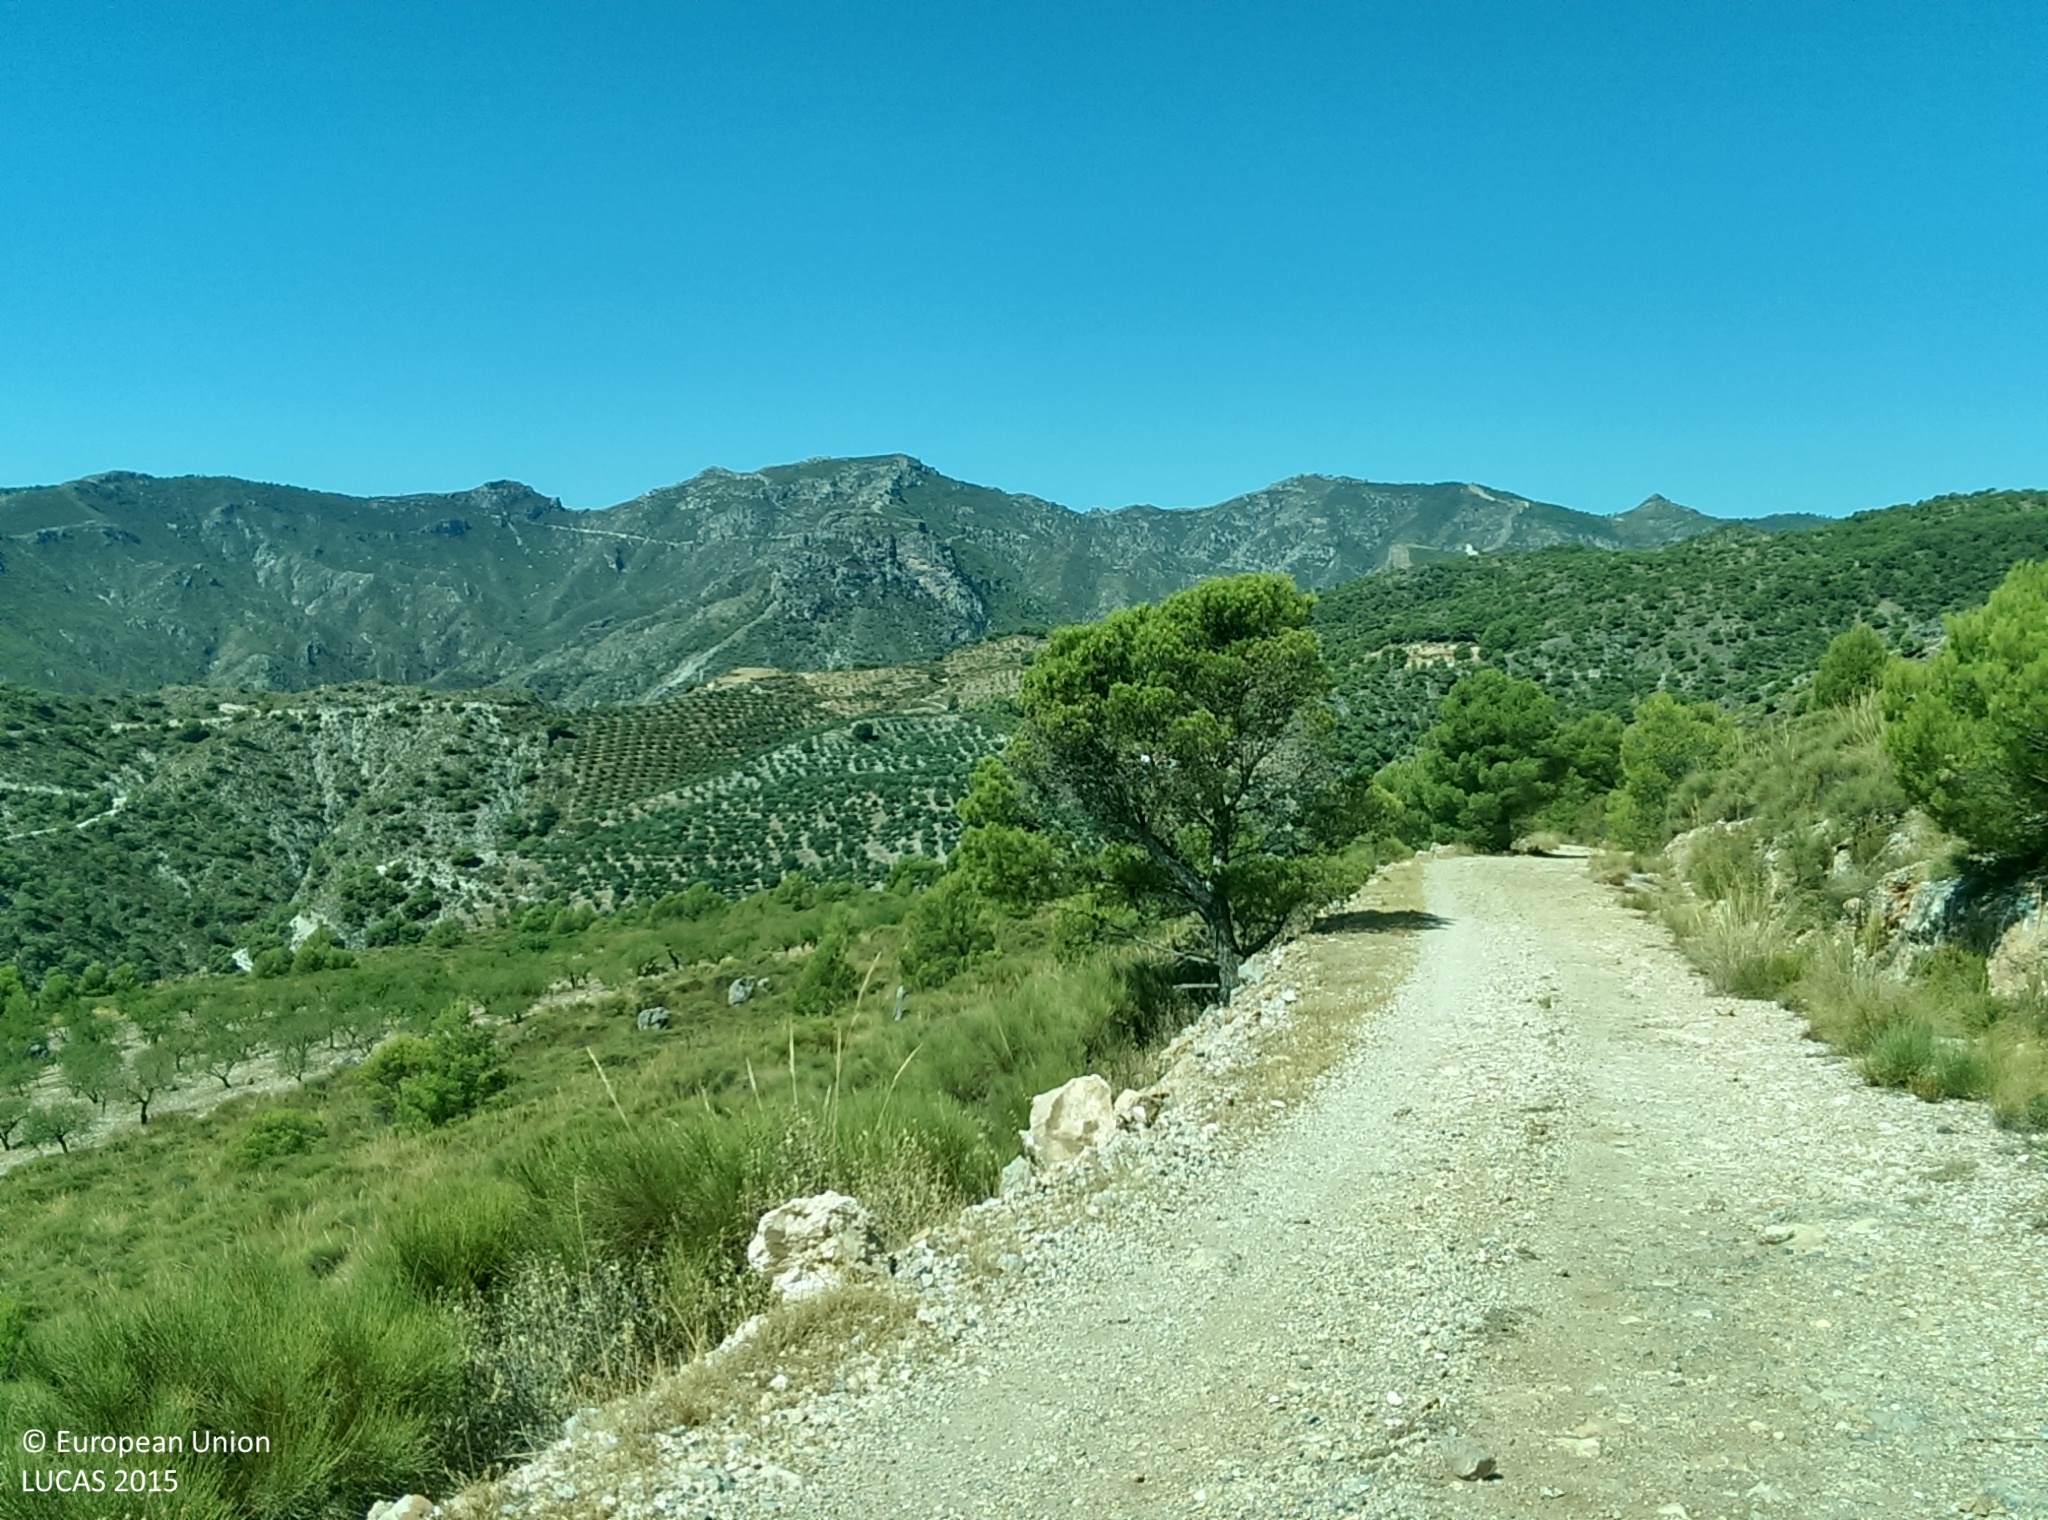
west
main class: Shrubland
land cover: Shrubland with sparse tree cover
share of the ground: > 75 %
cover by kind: shrubs 90 %, coniferous forest trees 5 %, herbaceous plants 5 %
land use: Semi-natural and natural areas not in use
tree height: < 5 m
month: August
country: ES
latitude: 36.8736
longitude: -3.6148
